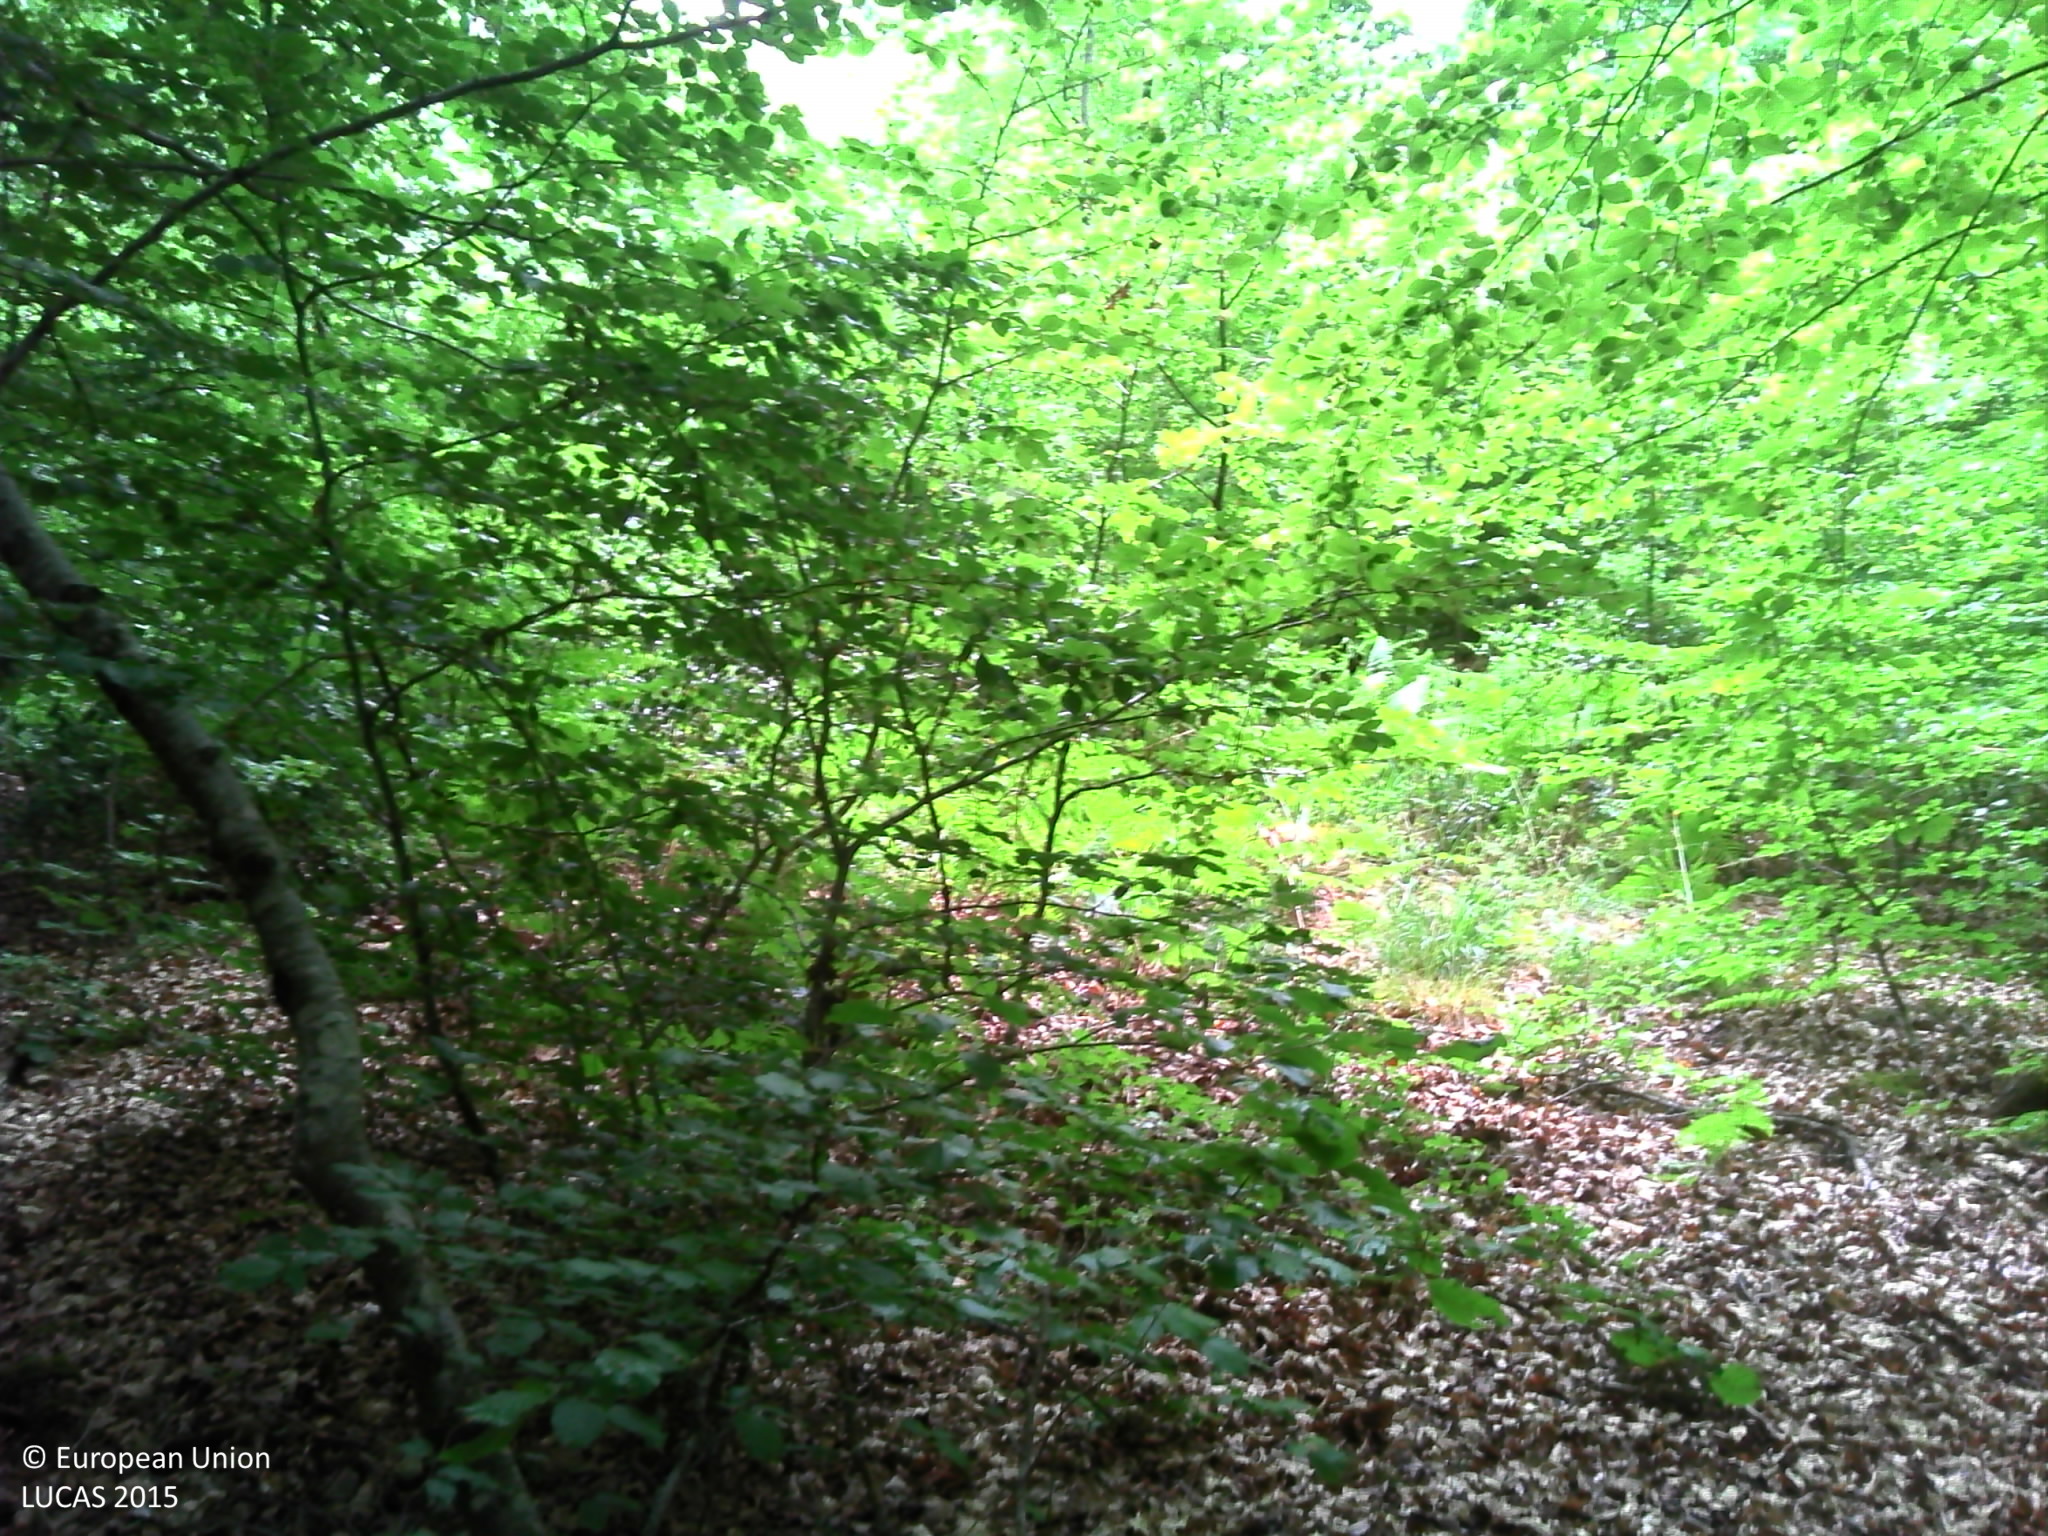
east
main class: Woodland
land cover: Broadleaved woodland
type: beech forest
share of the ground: > 75 %
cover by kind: broadleaved forest trees 85 %, unconsolidated bare surface 10 %, herbaceous plants 5 %
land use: Forestry
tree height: > 5 m
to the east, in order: Broadleaved woodland
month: June
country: FR
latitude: 47.5326
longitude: 6.3486
